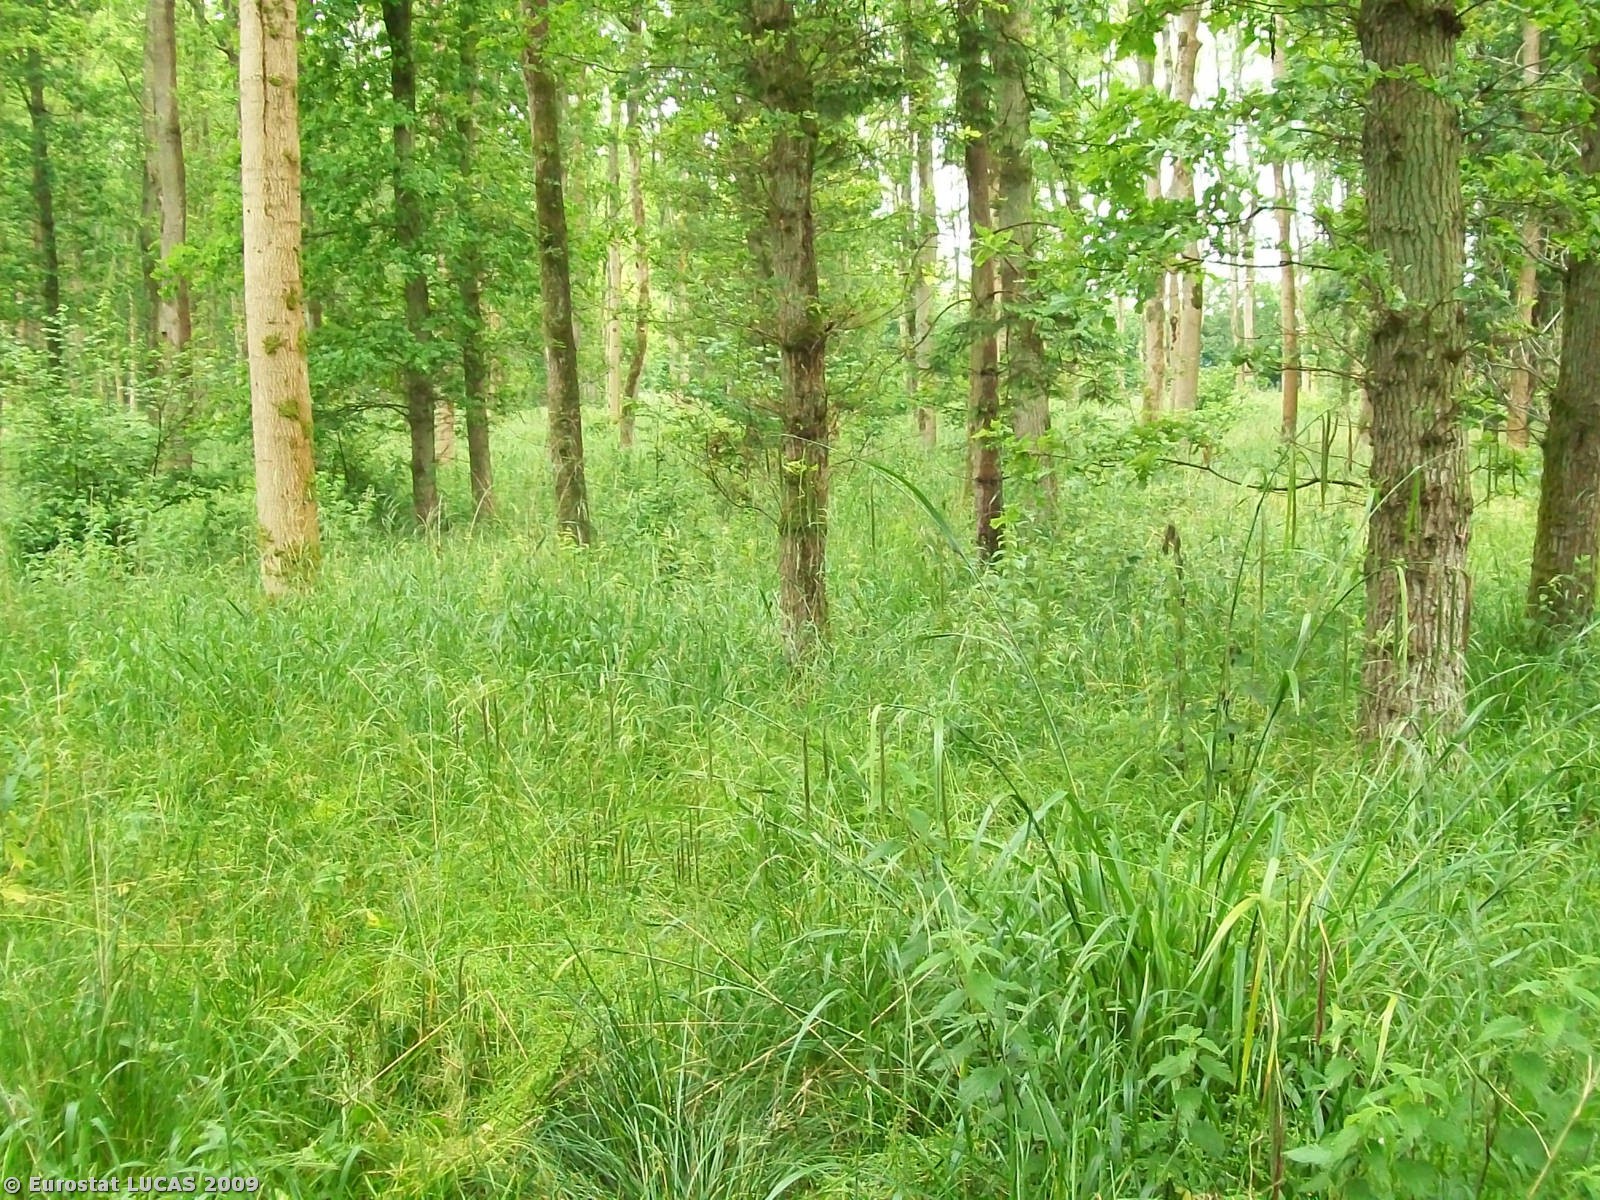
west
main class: Woodland
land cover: Broadleaved woodland
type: mesophytic deciduous forest
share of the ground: > 75 %
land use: Sport
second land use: Community services
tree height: > 5 m
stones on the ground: < 10 %
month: June
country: GB
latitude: 51.2161
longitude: -2.2165
